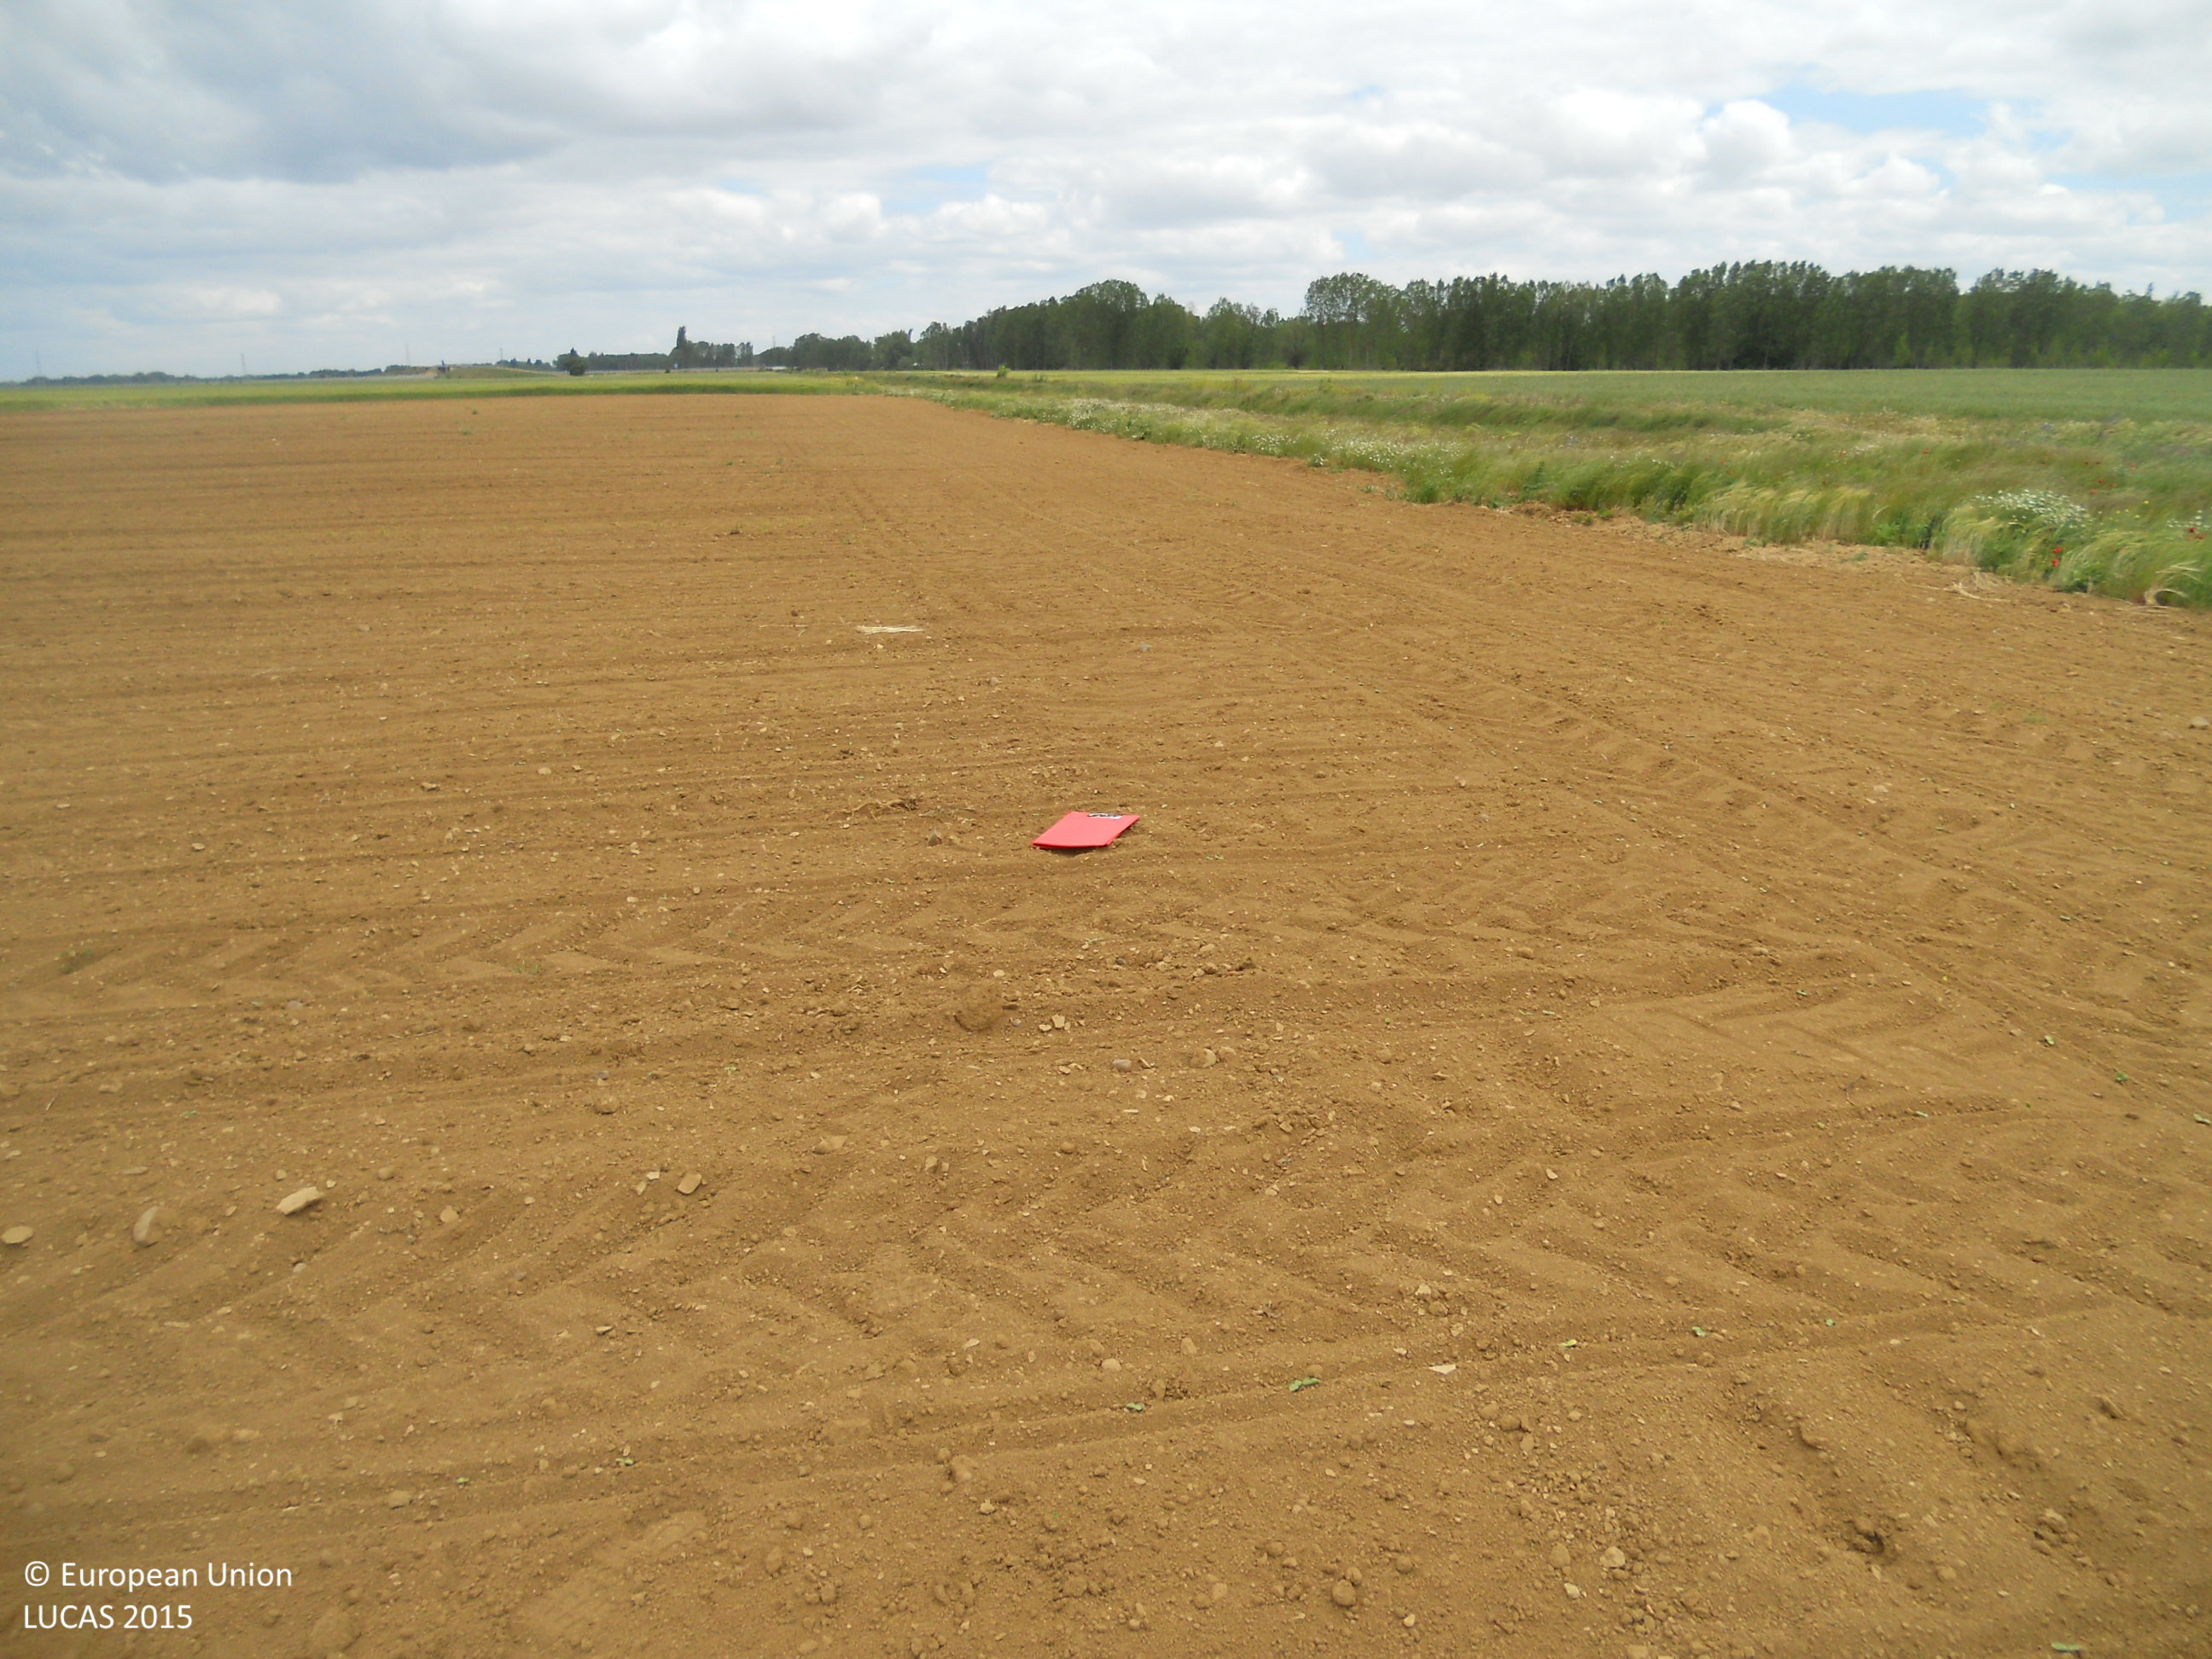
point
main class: Cropland
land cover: Sunflower
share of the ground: < 10 %
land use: Agriculture (excluding fallow land and kitchen gardens)
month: May
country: ES
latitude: 42.4244
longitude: -4.4023
